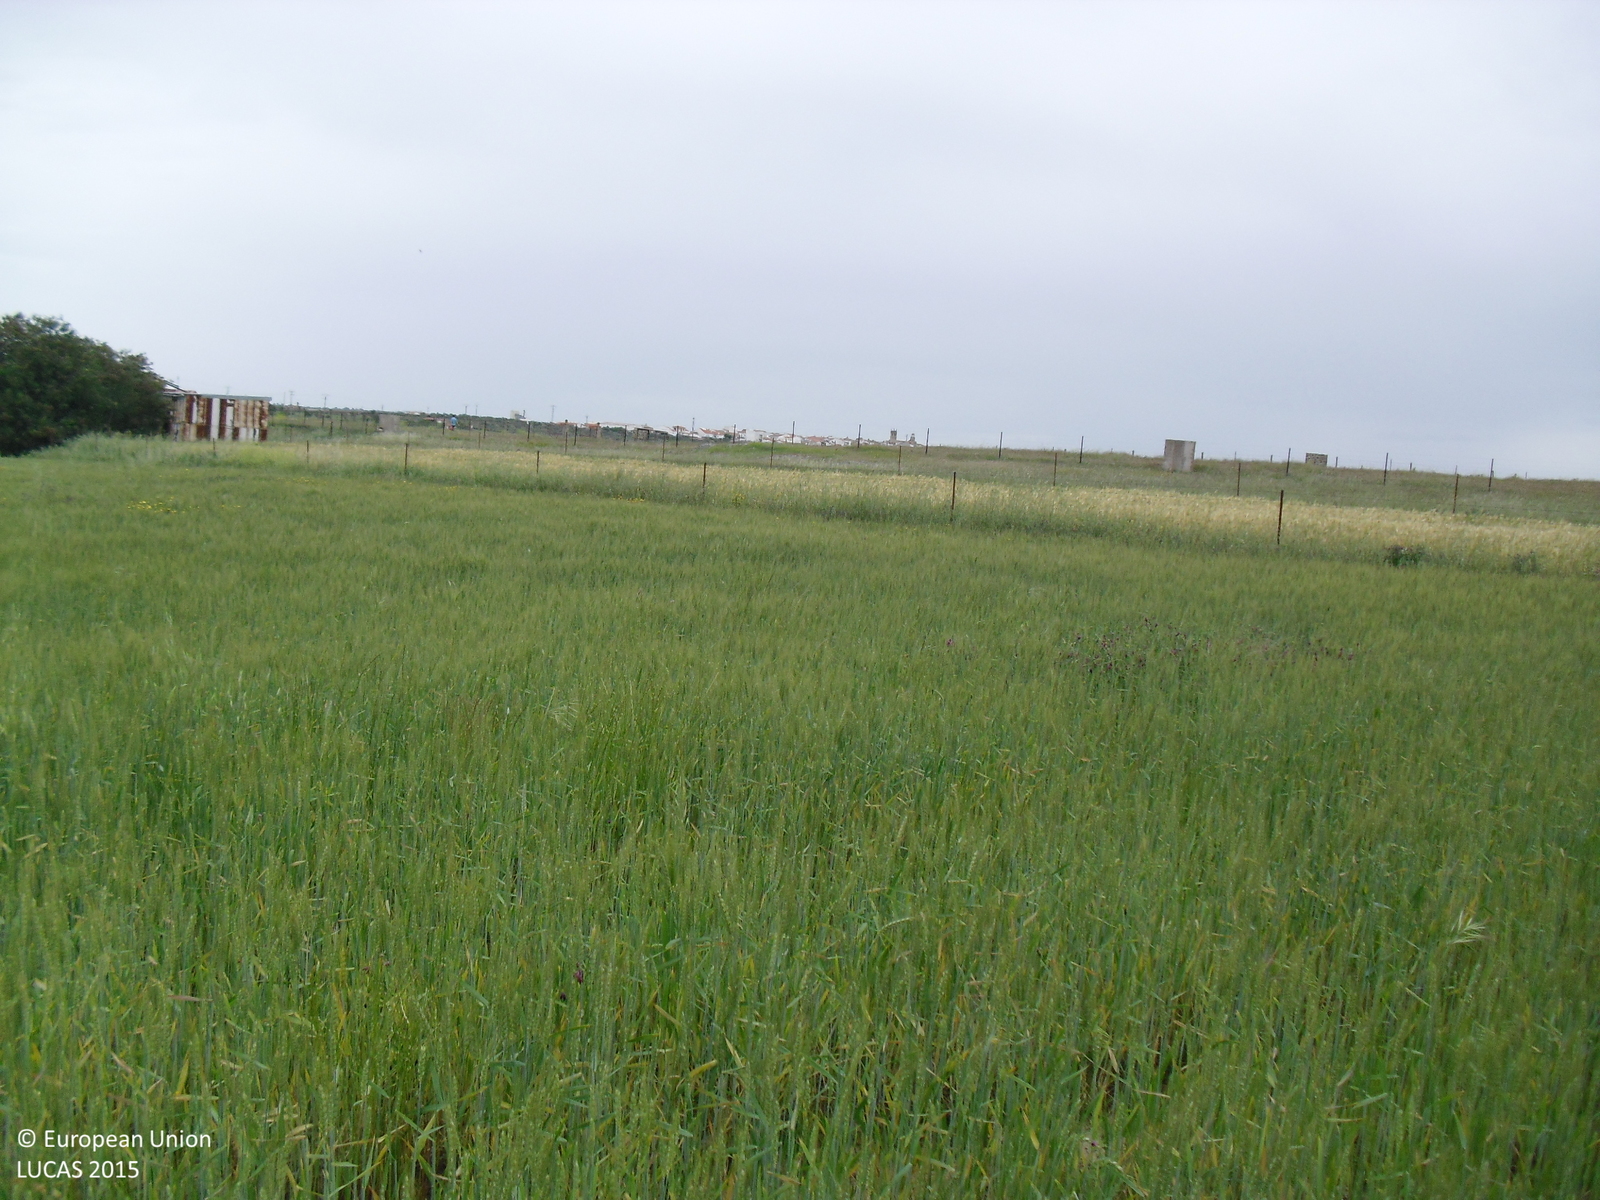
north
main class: Cropland
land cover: Common wheat
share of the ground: > 75 %
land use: Agriculture (excluding fallow land and kitchen gardens)
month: April
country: ES
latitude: 39.4703
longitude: -6.5901
